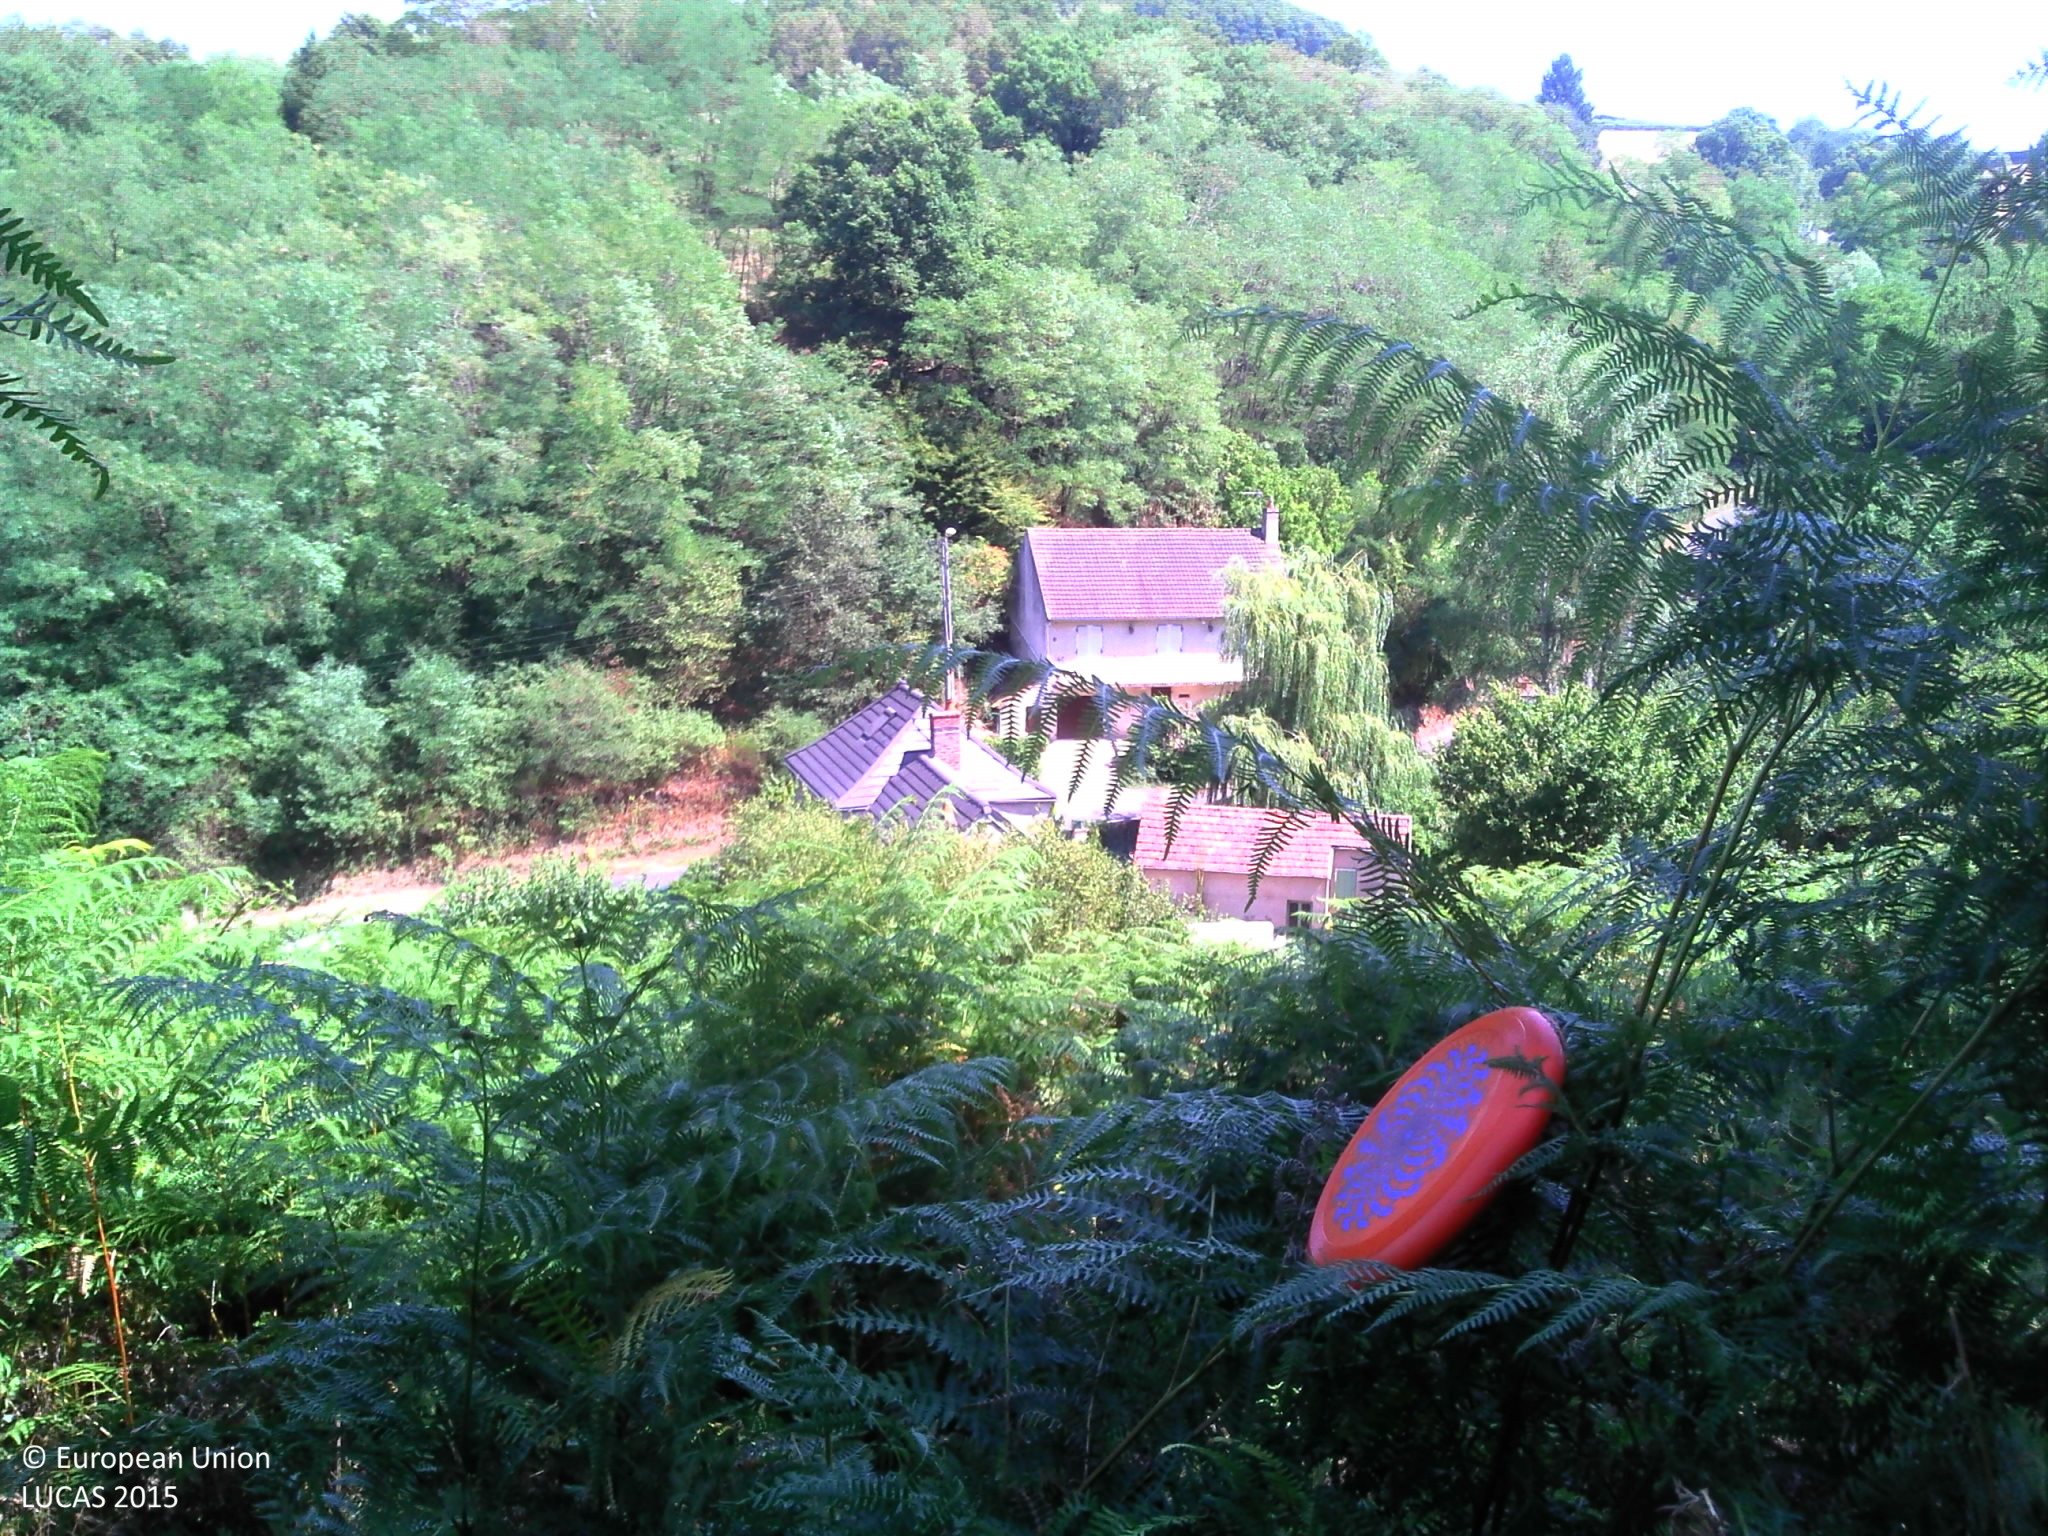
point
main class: Grassland
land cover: Spontaneously vegetated surfaces
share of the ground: > 75 %
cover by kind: herbaceous plants 95 %, shrubs 5 %
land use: Semi-natural and natural areas not in use
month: August
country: FR
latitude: 46.8198
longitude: 4.4299
